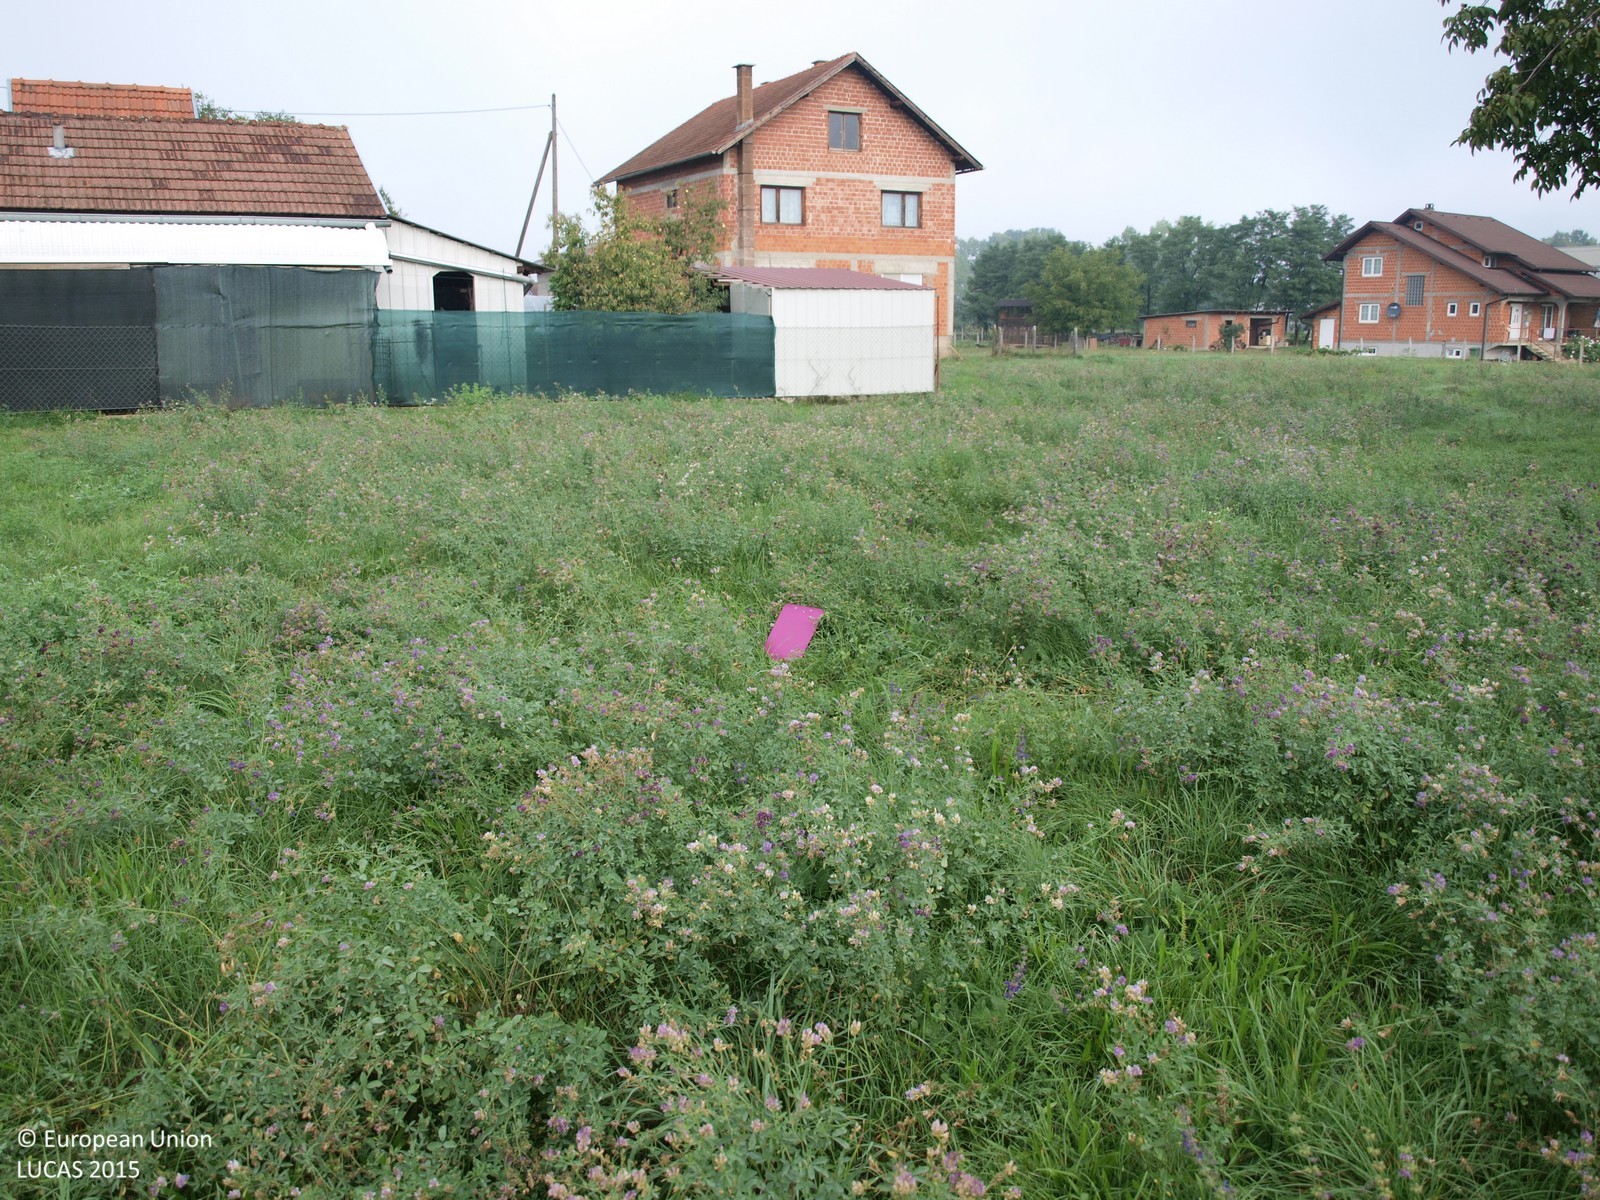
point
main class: Grassland
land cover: Grassland without tree/shrub cover
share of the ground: > 75 %
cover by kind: herbaceous plants 100 %
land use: Agriculture (excluding fallow land and kitchen gardens)
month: September
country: HR
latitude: 45.7628
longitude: 16.0796
